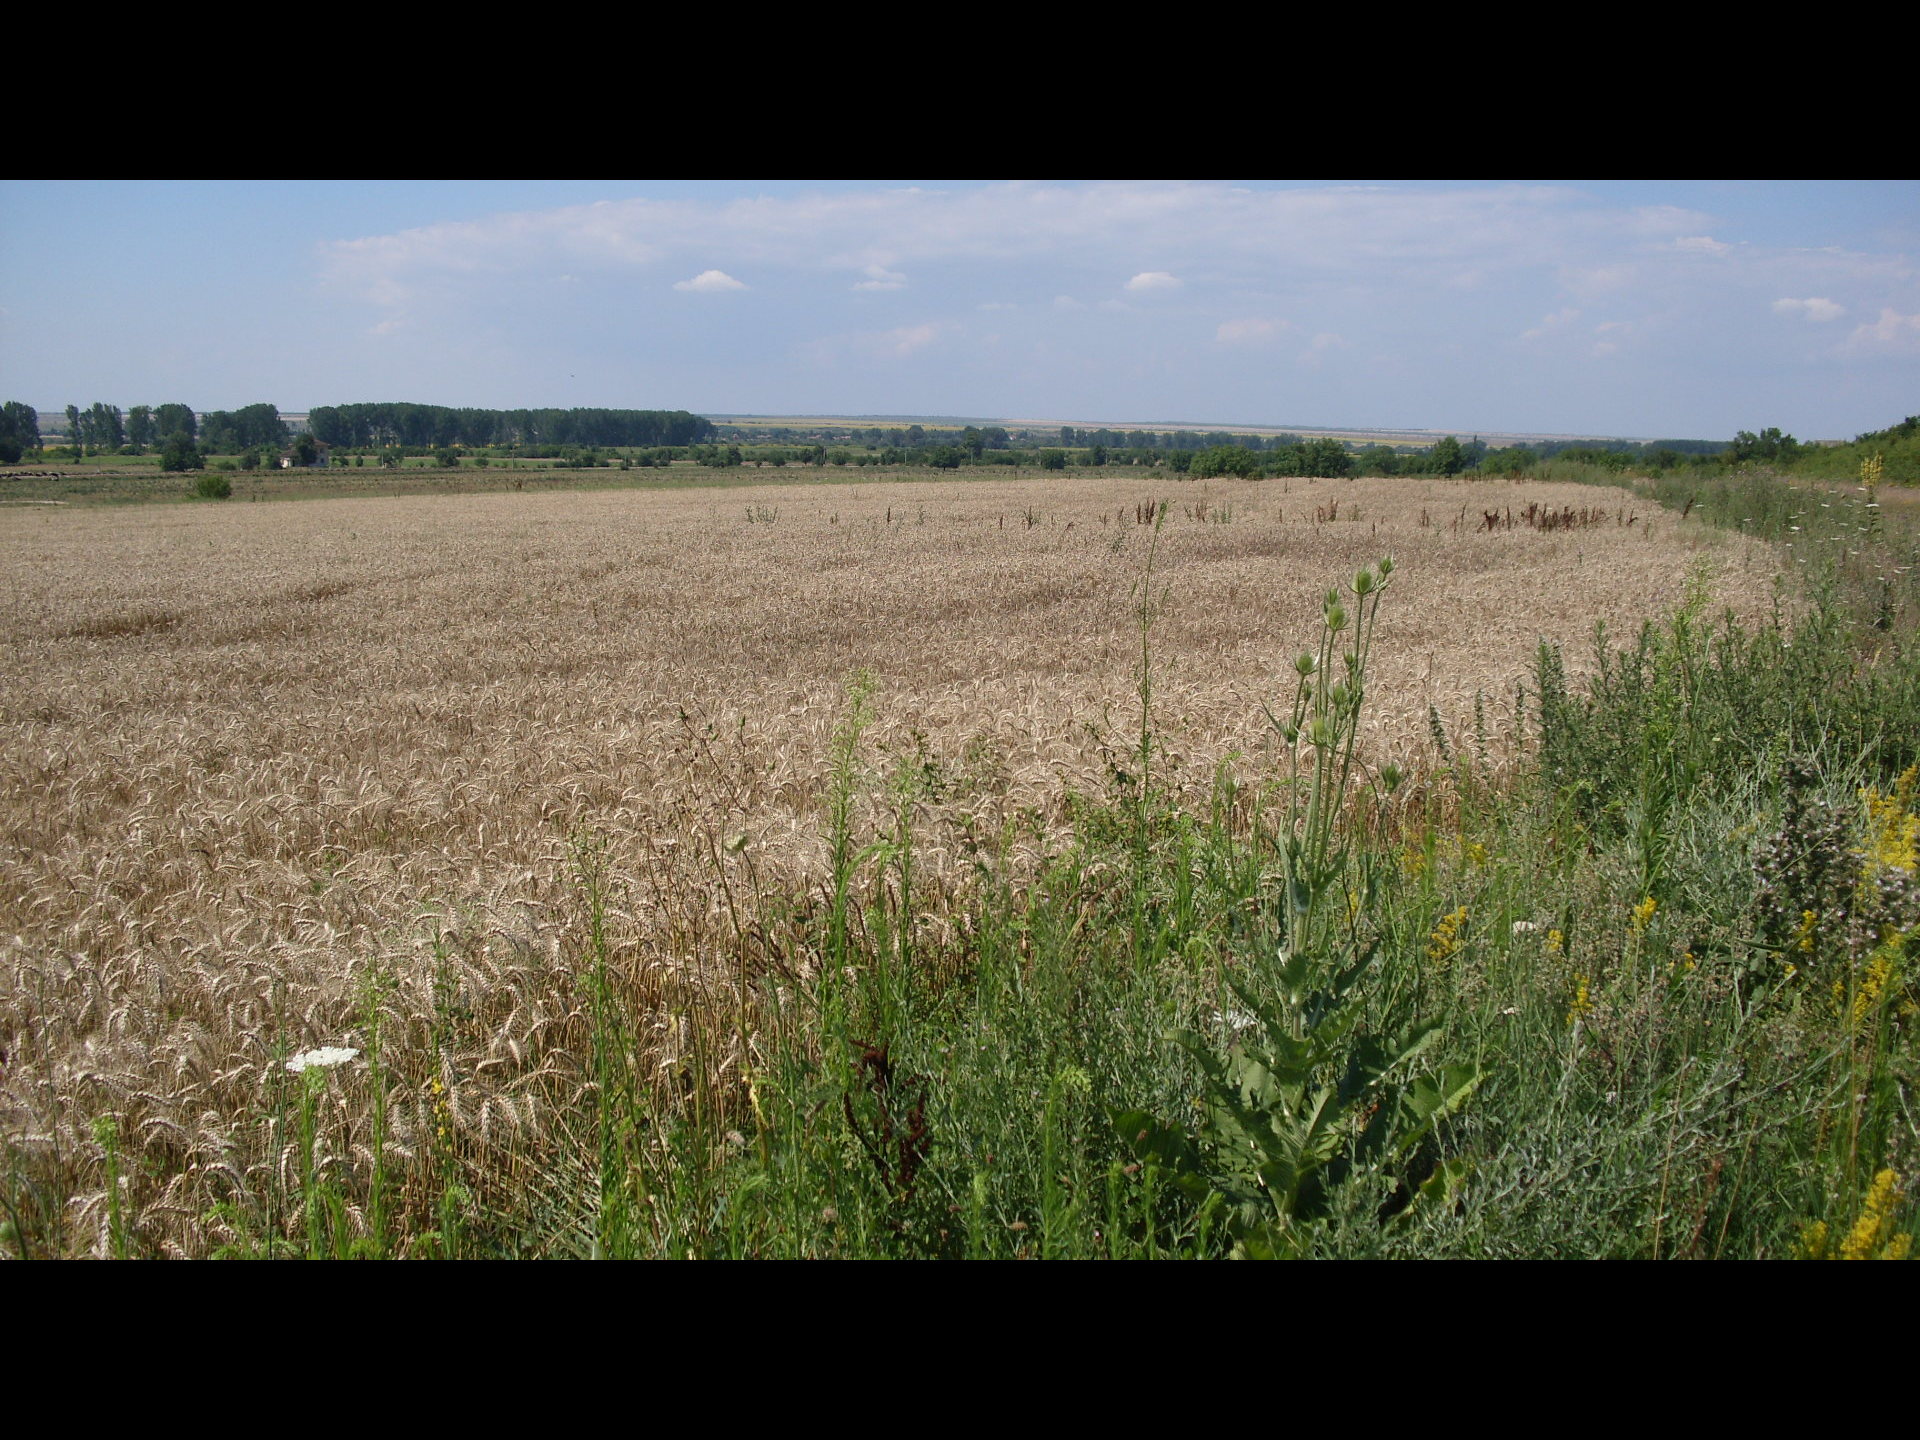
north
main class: Grassland
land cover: Spontaneously vegetated surfaces
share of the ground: > 75 %
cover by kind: herbaceous plants 100 %
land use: Agriculture (excluding fallow land and kitchen gardens)
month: July
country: BG
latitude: 43.6801
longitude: 23.1021
